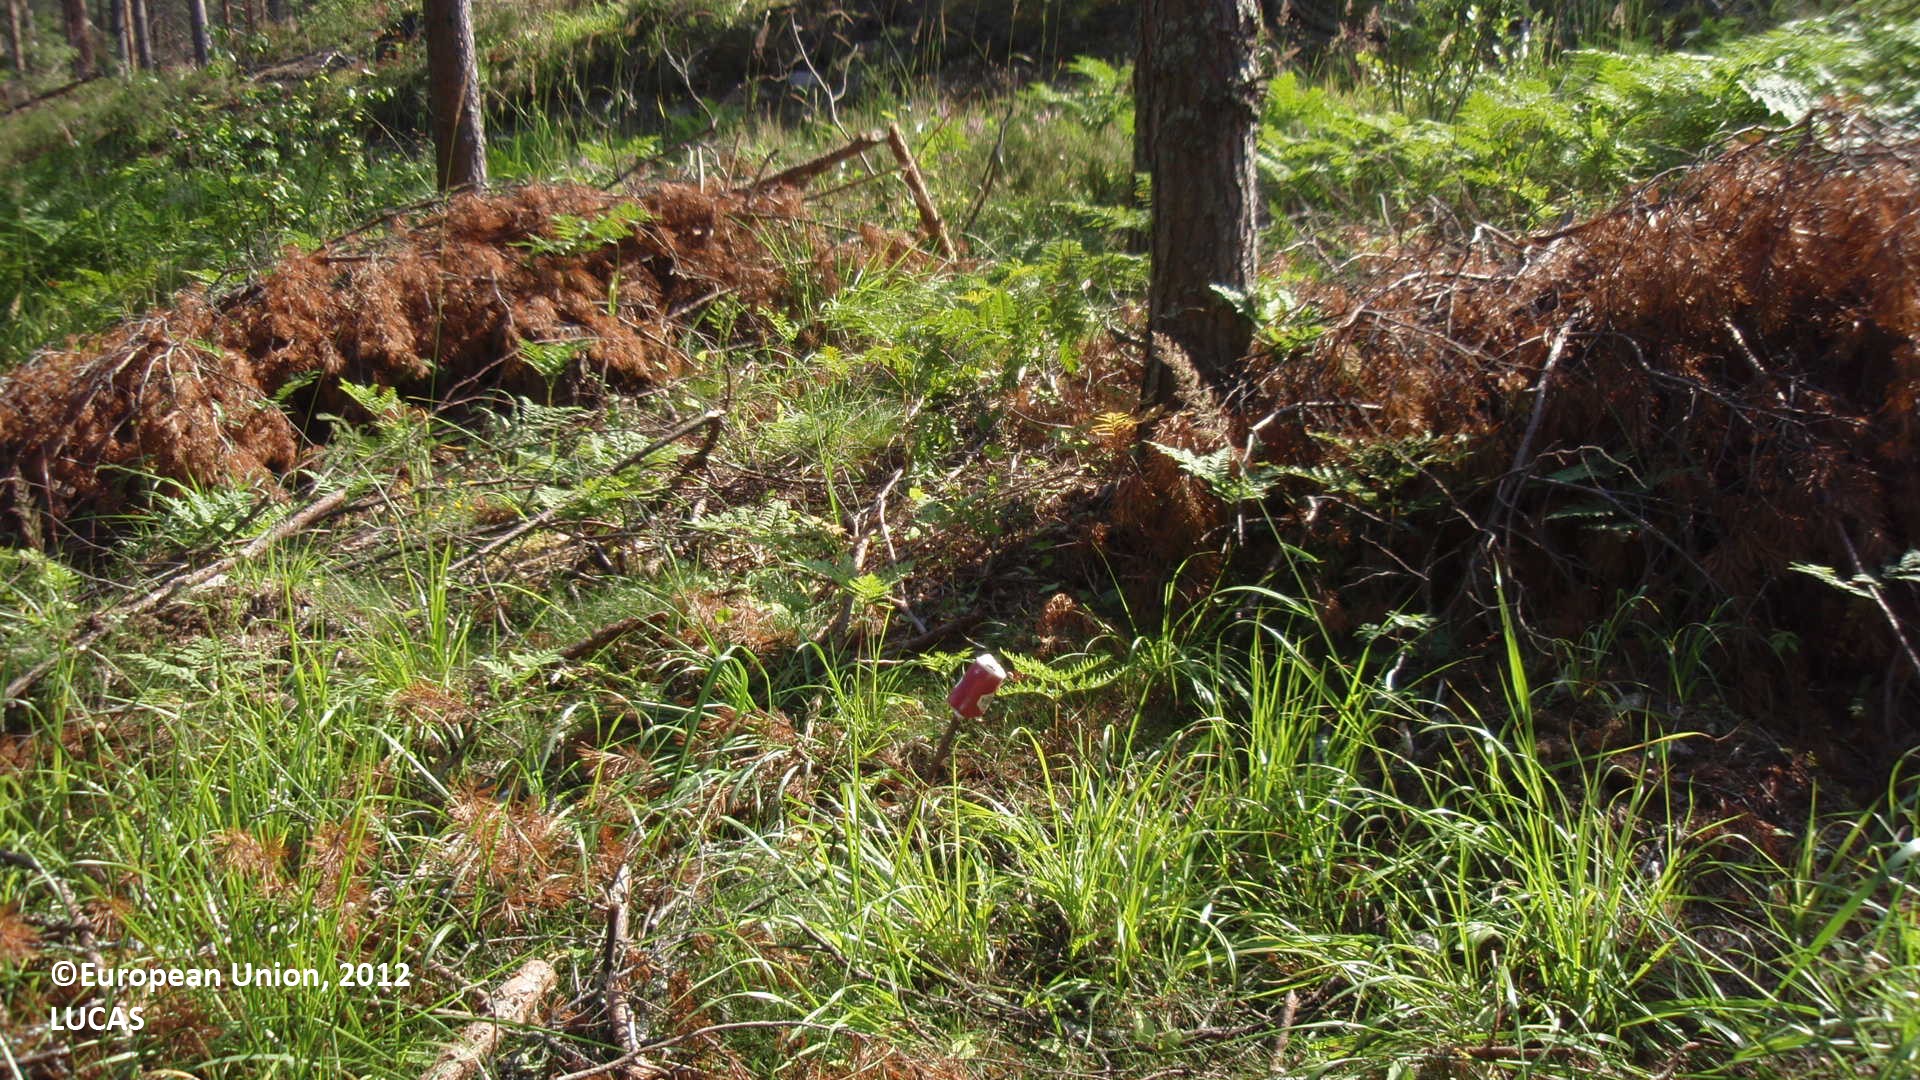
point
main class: Woodland
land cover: Pine dominated coniferous woodland
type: boreal forest
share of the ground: 50 - 75 %
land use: Forestry
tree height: > 5 m
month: July
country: FI
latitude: 61.3889
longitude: 28.3861
